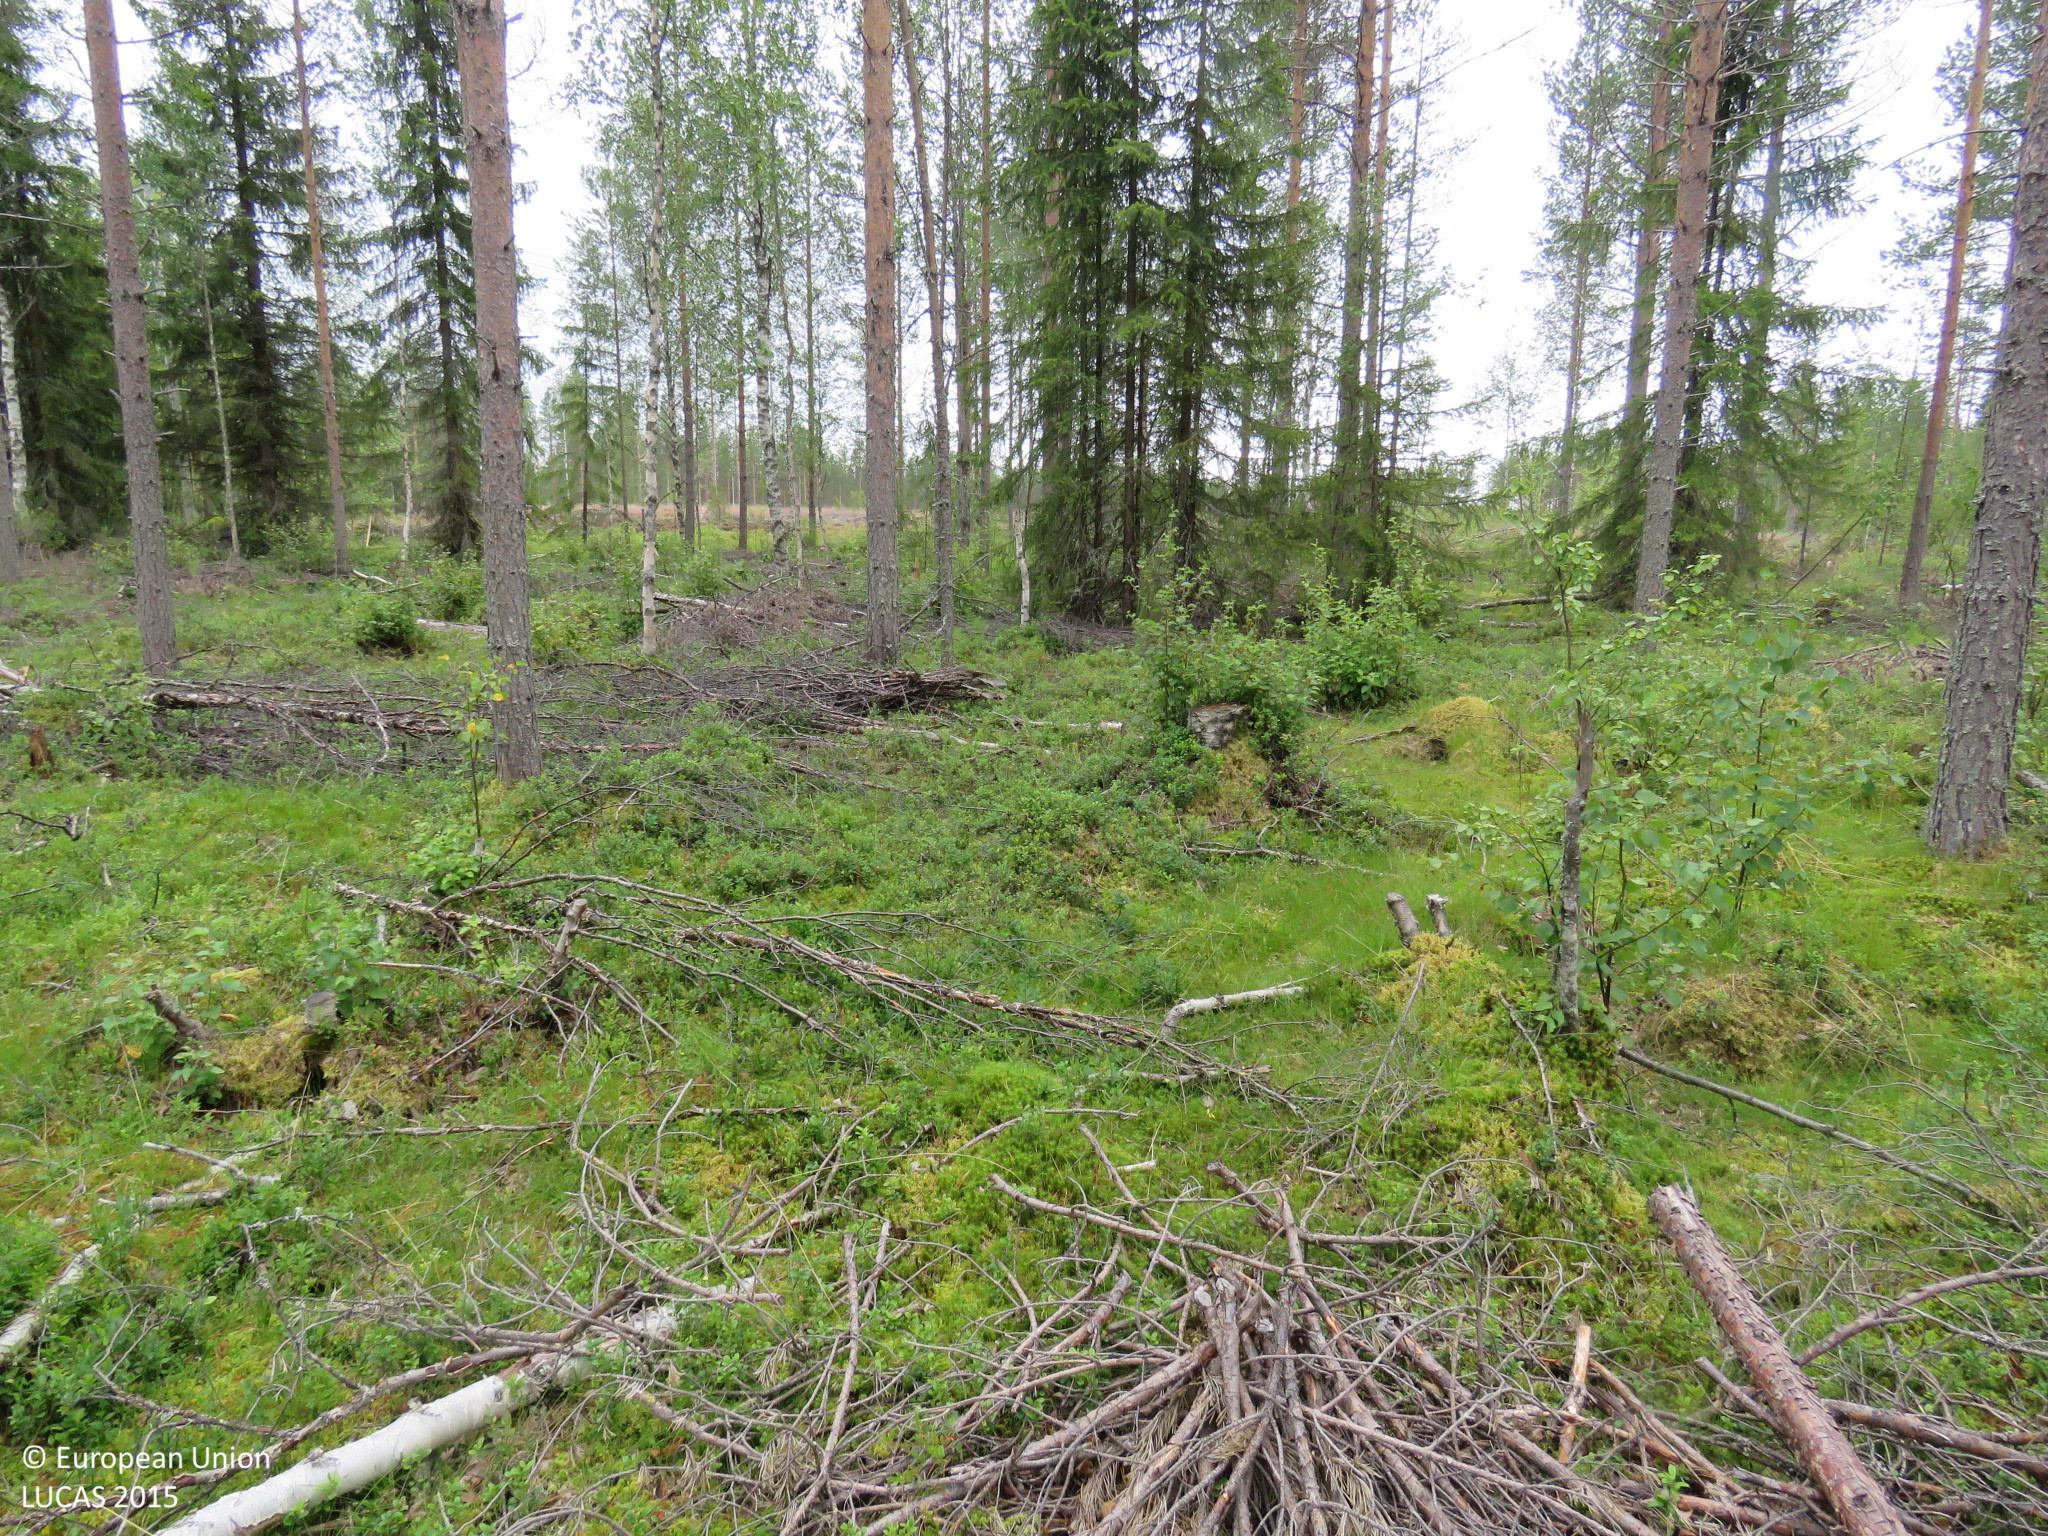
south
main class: Woodland
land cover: Other mixed woodland
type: boreal forest
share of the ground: 50 - 75 %
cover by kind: coniferous forest trees 40 %, broadleaved forest trees 25 %, shrubs 20 %, lichens and mosses 10 %, unconsolidated bare surface 5 %
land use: Forestry
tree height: > 5 m
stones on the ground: < 10 %
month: July
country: FI
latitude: 64.6087
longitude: 26.9513
